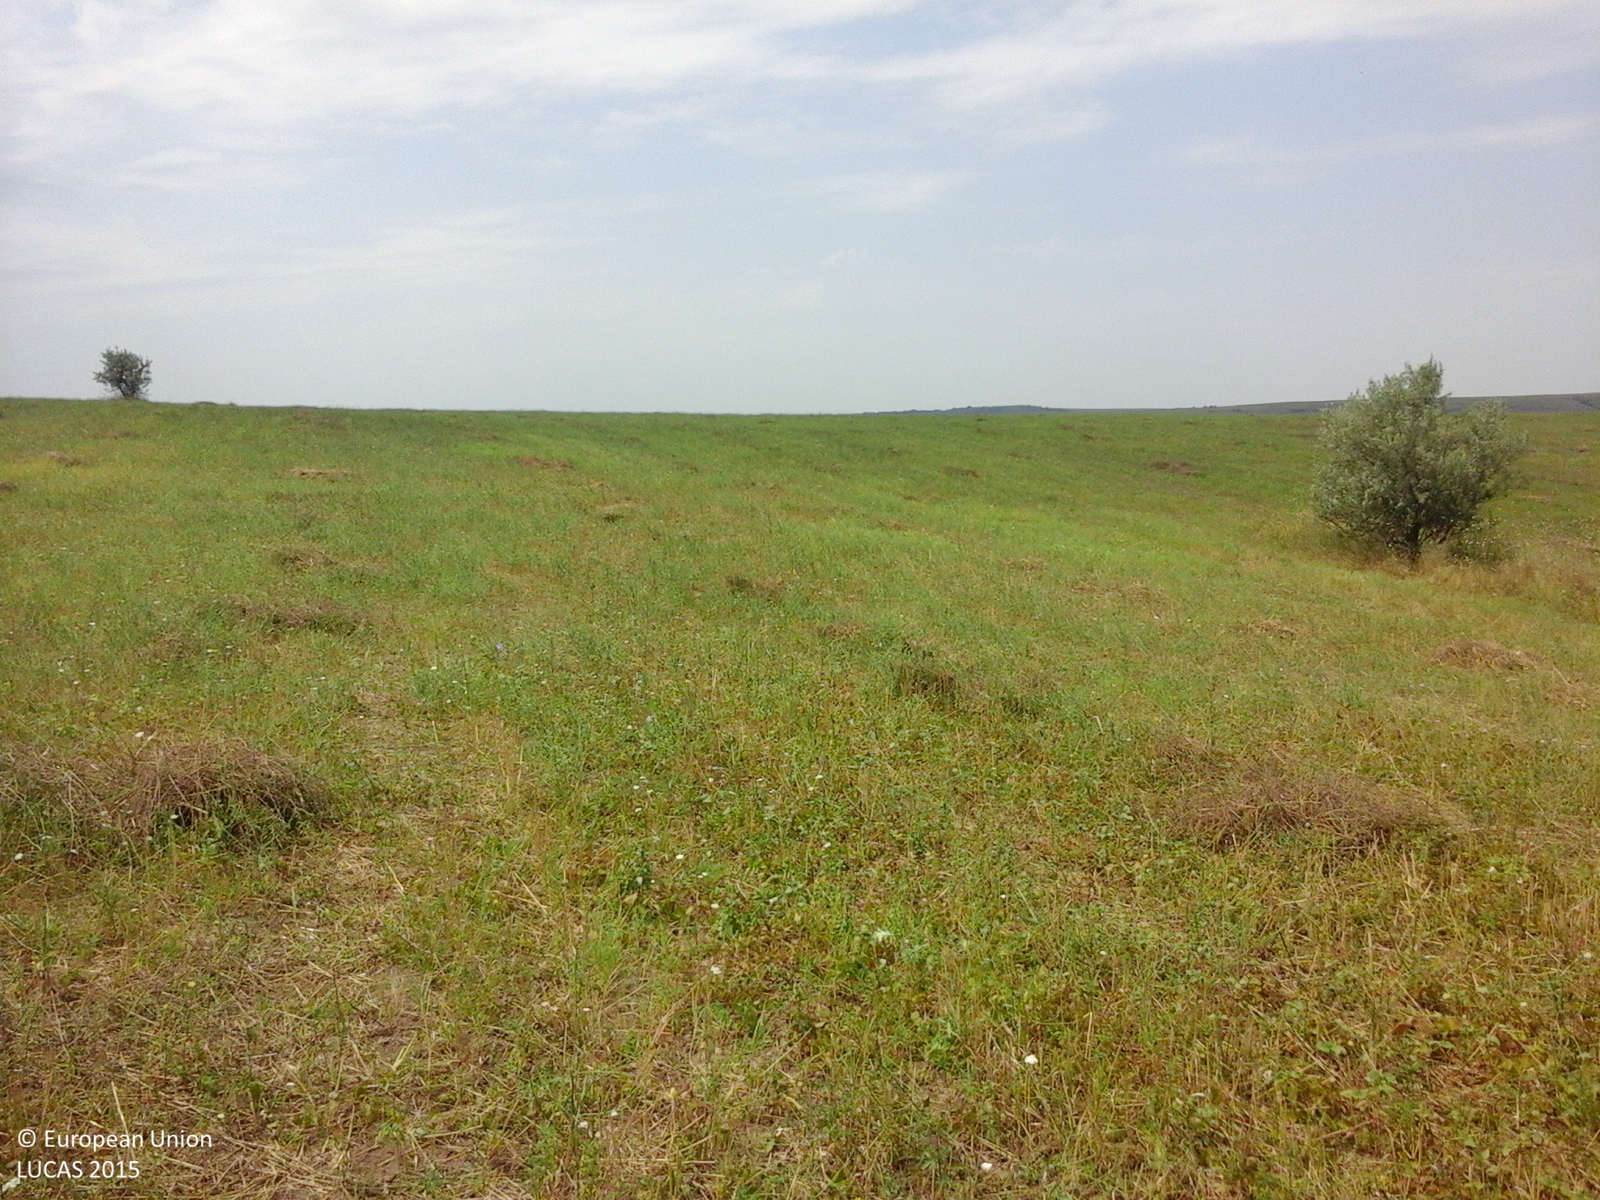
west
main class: Cropland
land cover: Common wheat
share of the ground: 10 - 25 %
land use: Agriculture (excluding fallow land and kitchen gardens)
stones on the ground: < 10 %
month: August
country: RO
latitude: 44.1623
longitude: 27.8953
